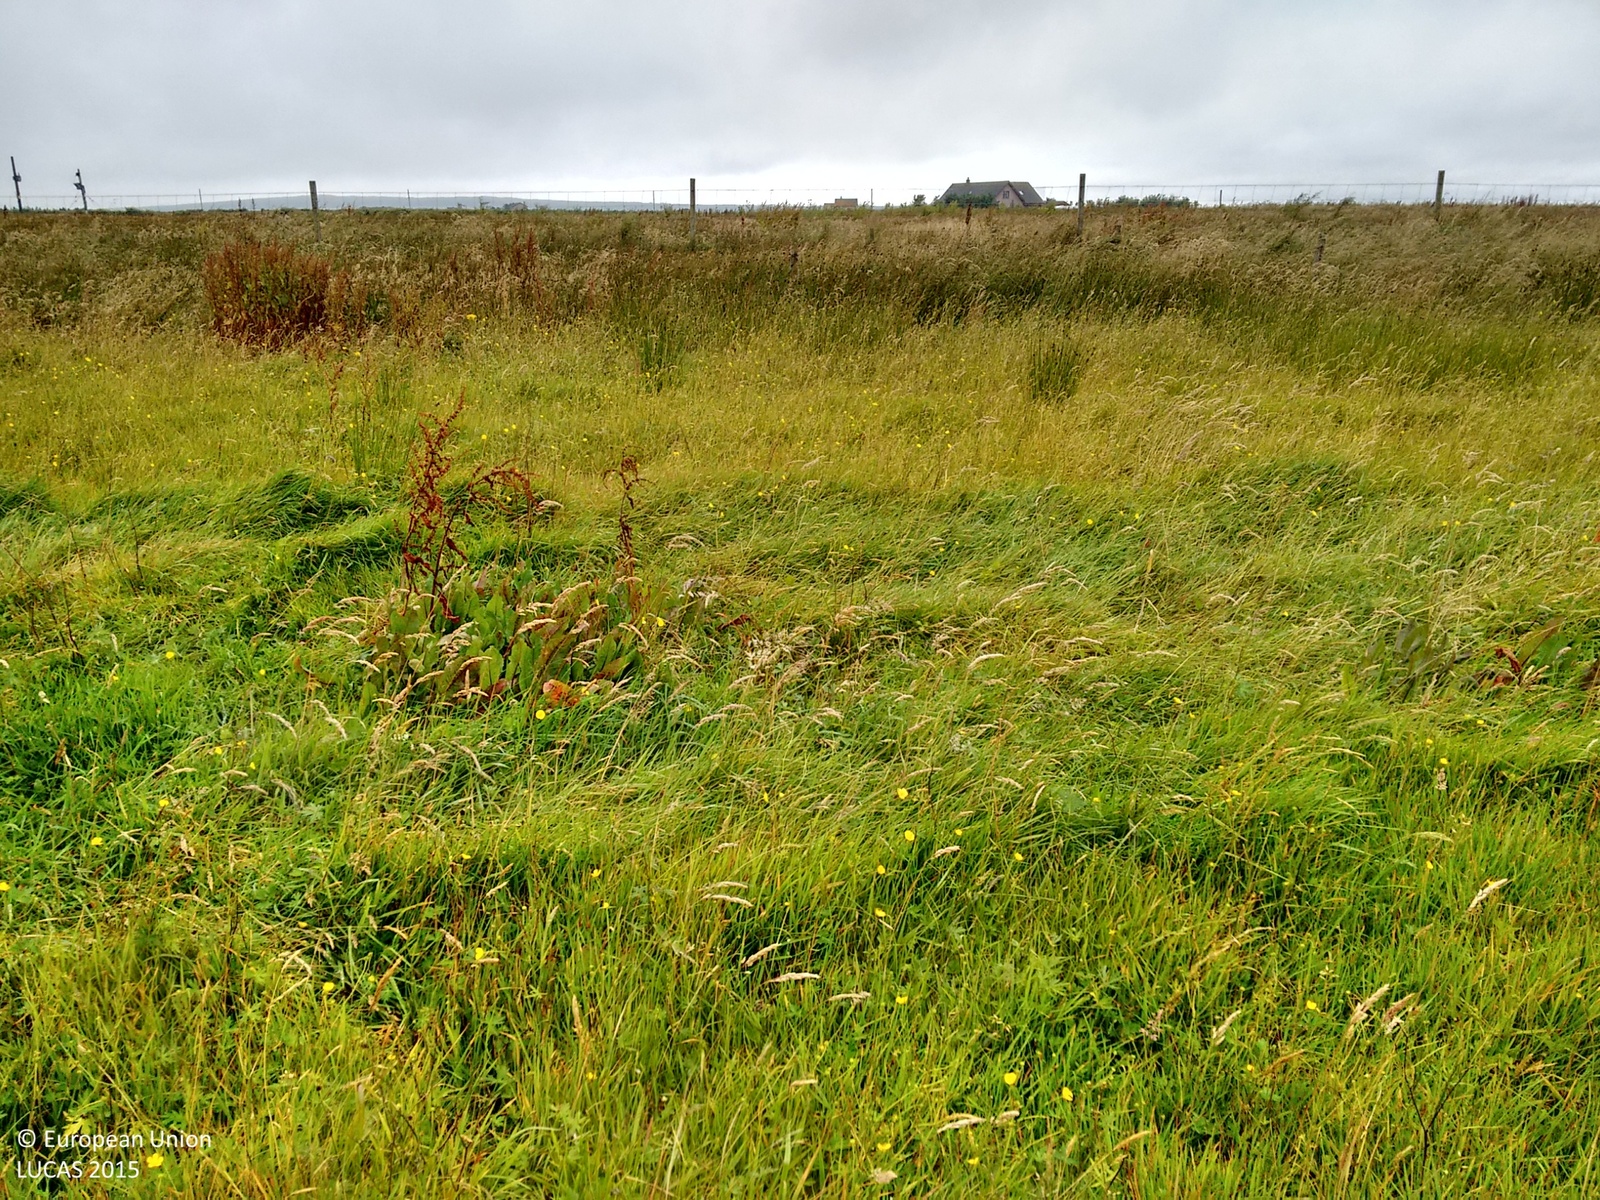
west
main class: Grassland
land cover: Grassland without tree/shrub cover
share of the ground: > 75 %
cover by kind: herbaceous plants 100 %
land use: Agriculture (excluding fallow land and kitchen gardens)
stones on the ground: < 10 %
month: August
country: GB
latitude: 58.4306
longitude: -3.1249
